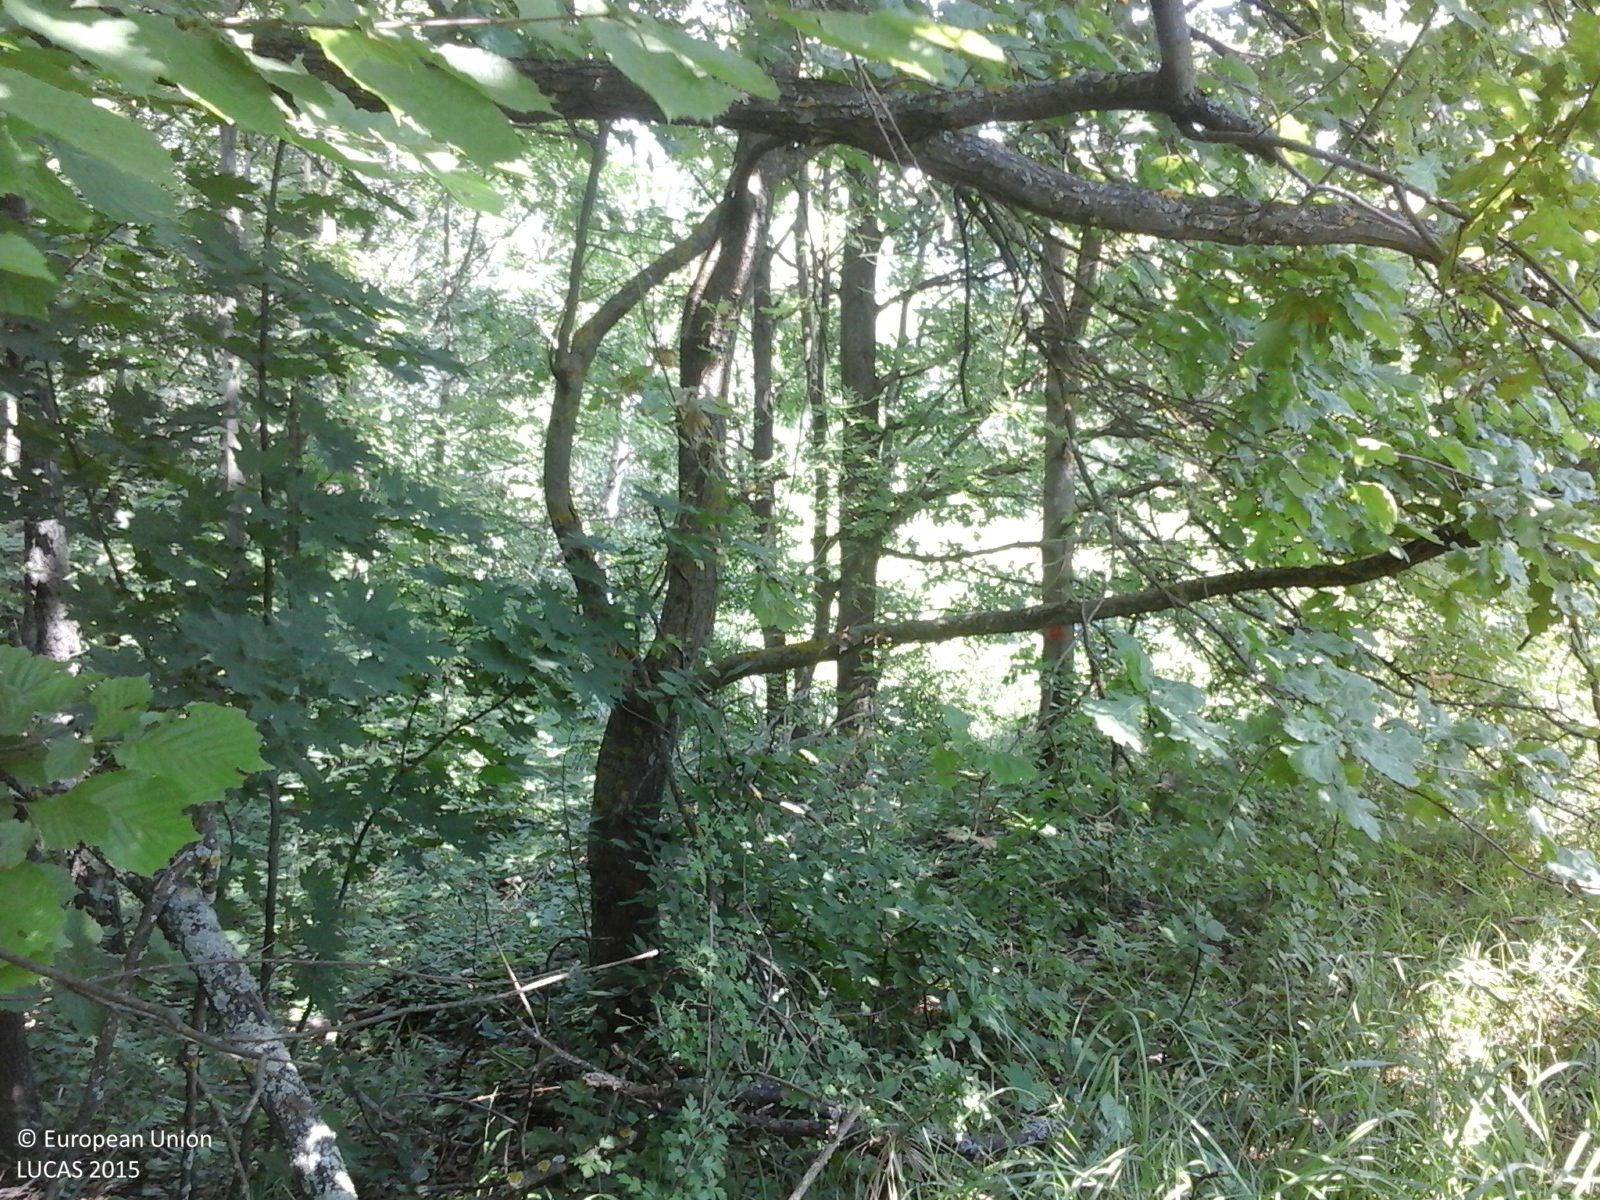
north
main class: Woodland
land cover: Broadleaved woodland
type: beech forest
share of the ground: > 75 %
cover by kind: broadleaved forest trees 85 %, herbaceous plants 10 %, shrubs 5 %
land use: Forestry
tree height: > 5 m
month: June
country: RO
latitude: 46.7415
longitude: 27.2372
